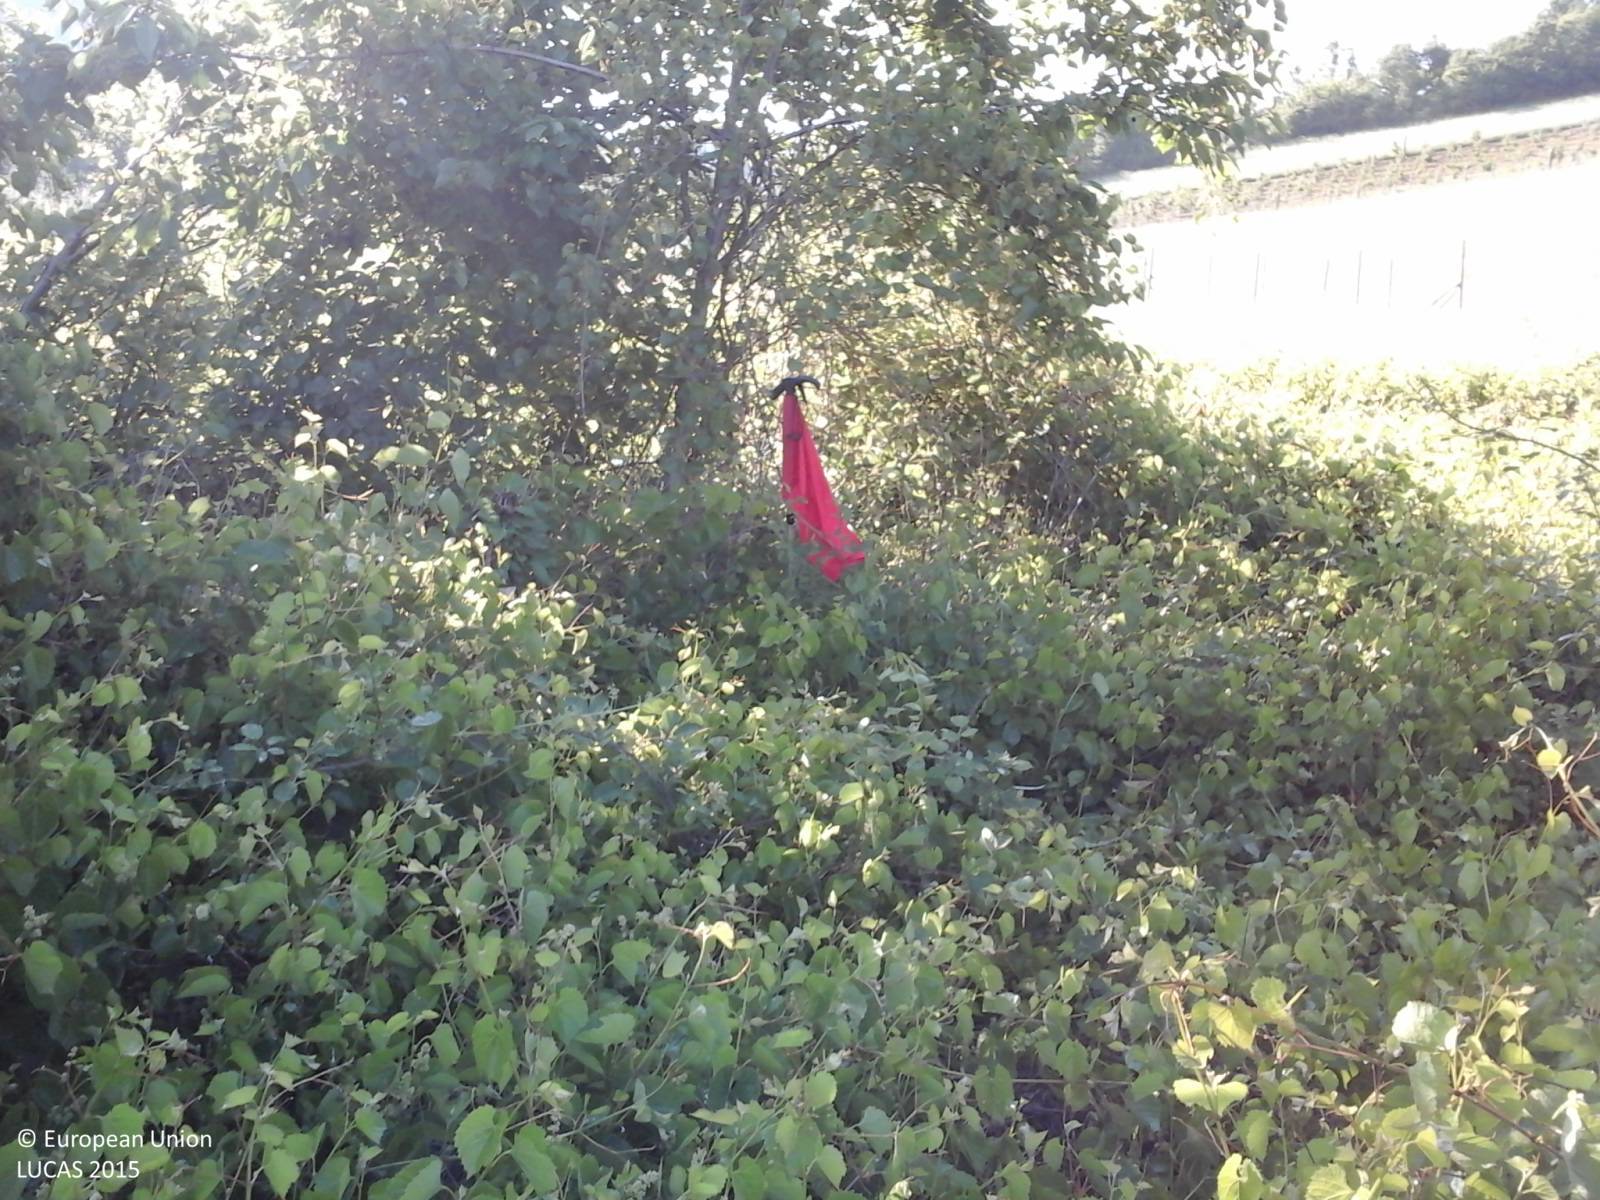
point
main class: Shrubland
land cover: Shrubland with sparse tree cover
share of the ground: > 75 %
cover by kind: shrubs 95 %, broadleaved forest trees 5 %
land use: Abandoned areas
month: June
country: IT
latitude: 42.0775
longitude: 13.7708
